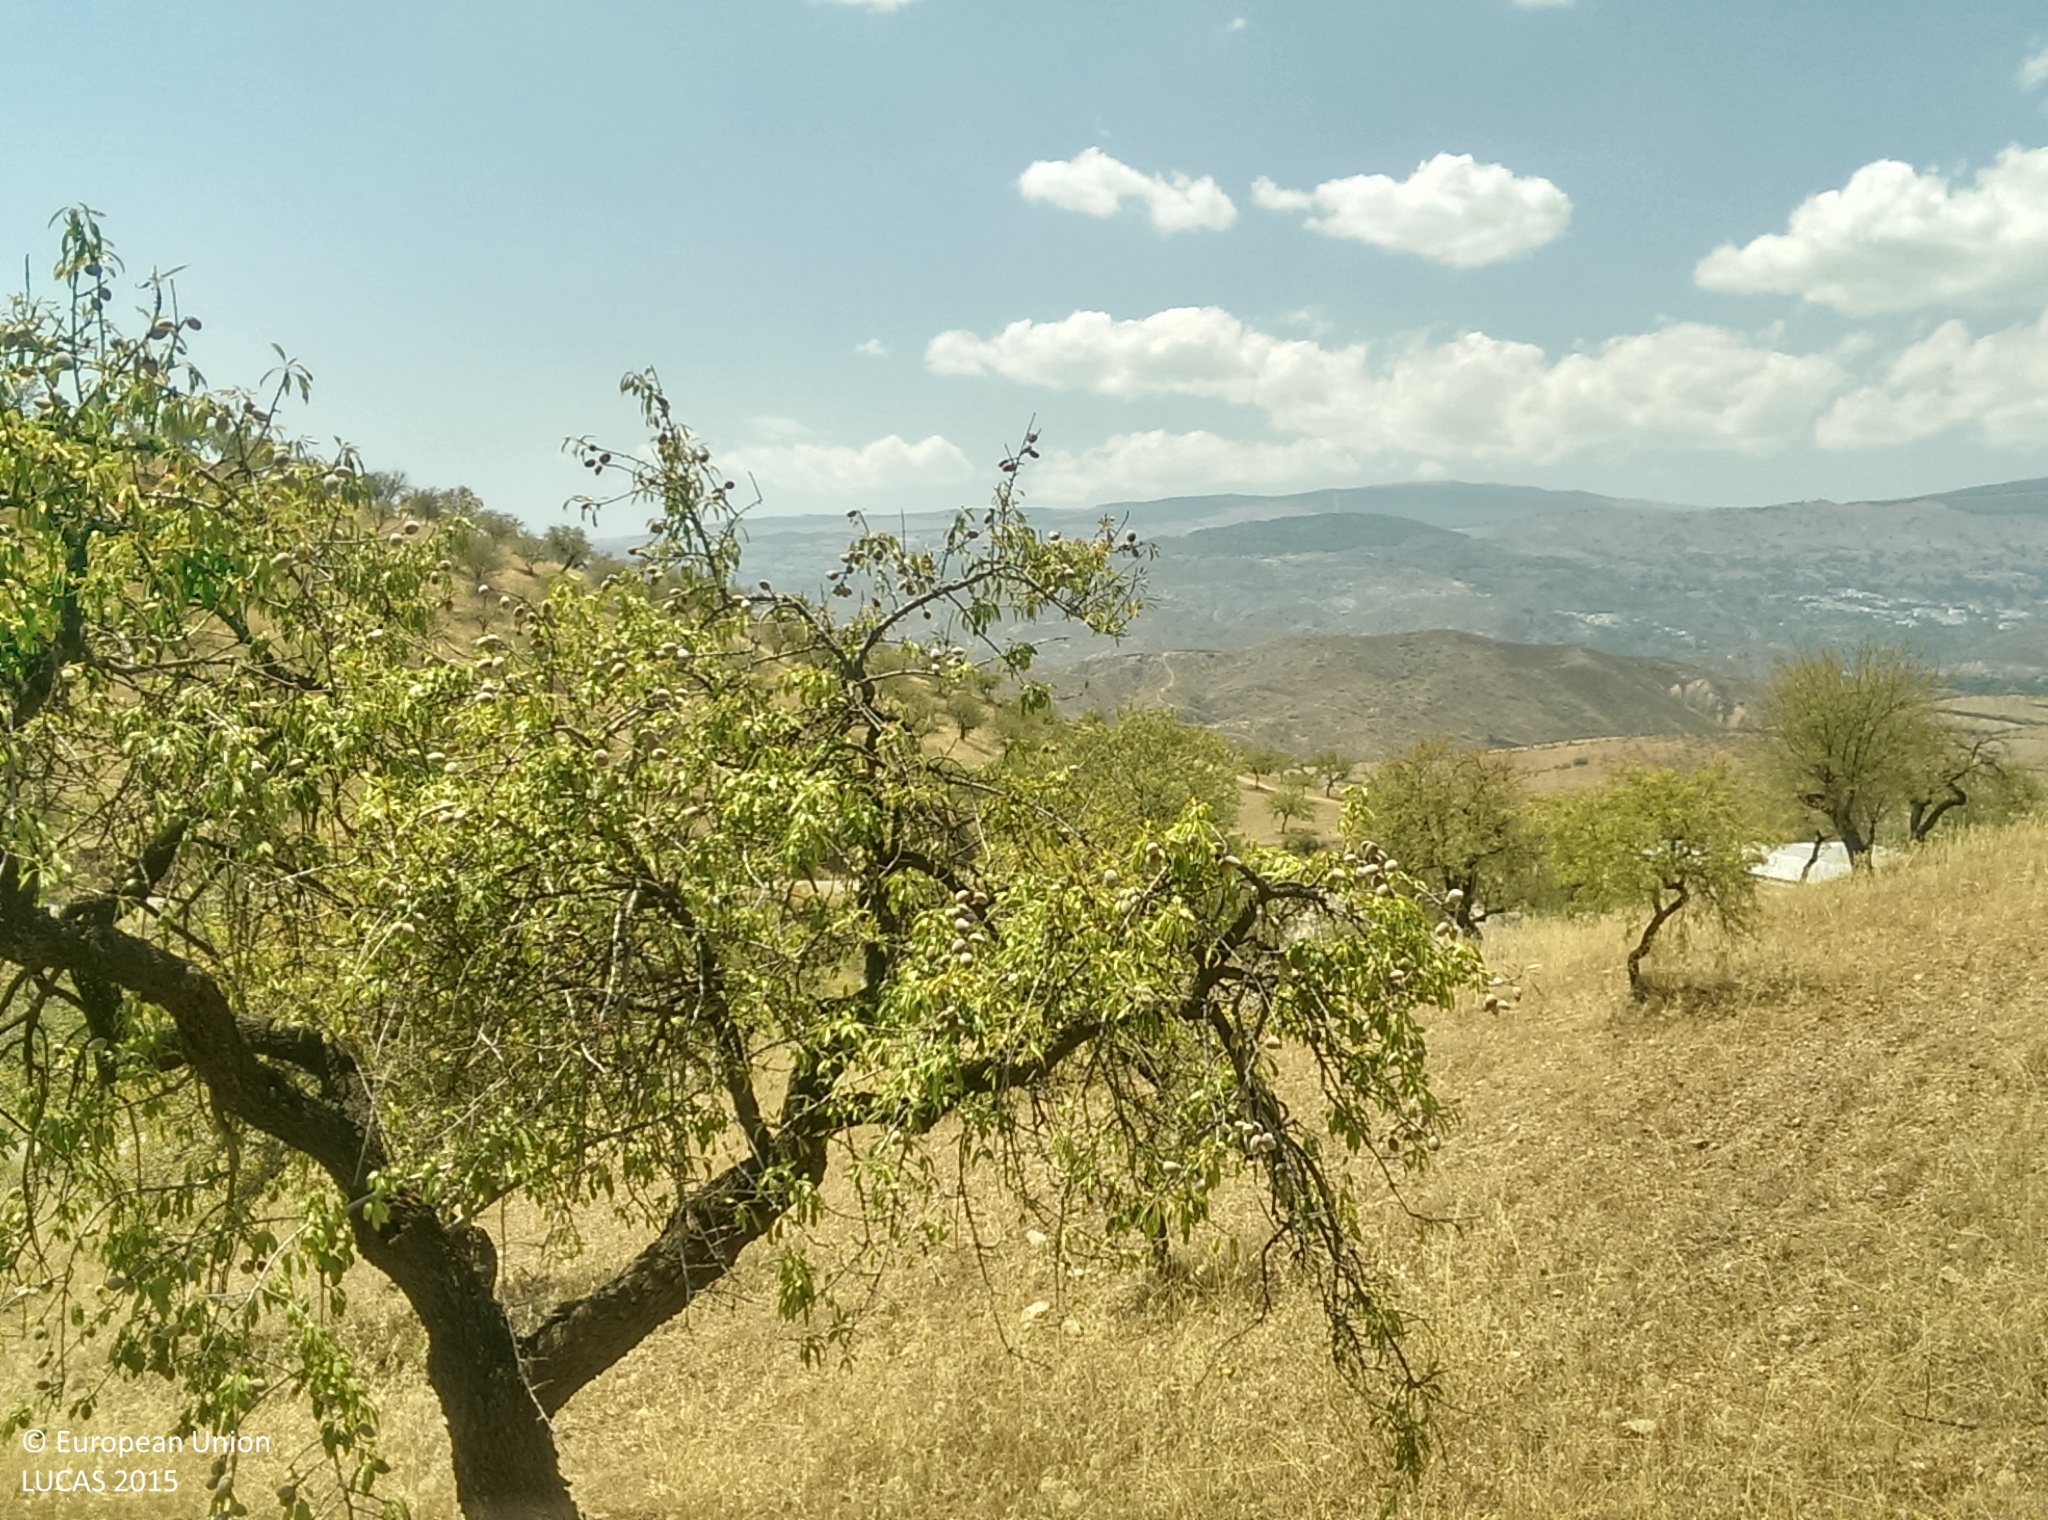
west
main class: Cropland
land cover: Nuts trees
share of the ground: 10 - 25 %
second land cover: Spontaneously vegetated surfaces
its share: 10 - 25 %
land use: Agriculture (excluding fallow land and kitchen gardens)
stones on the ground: 25 - 50 %
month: July
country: ES
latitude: 36.9460
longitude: -3.1081
